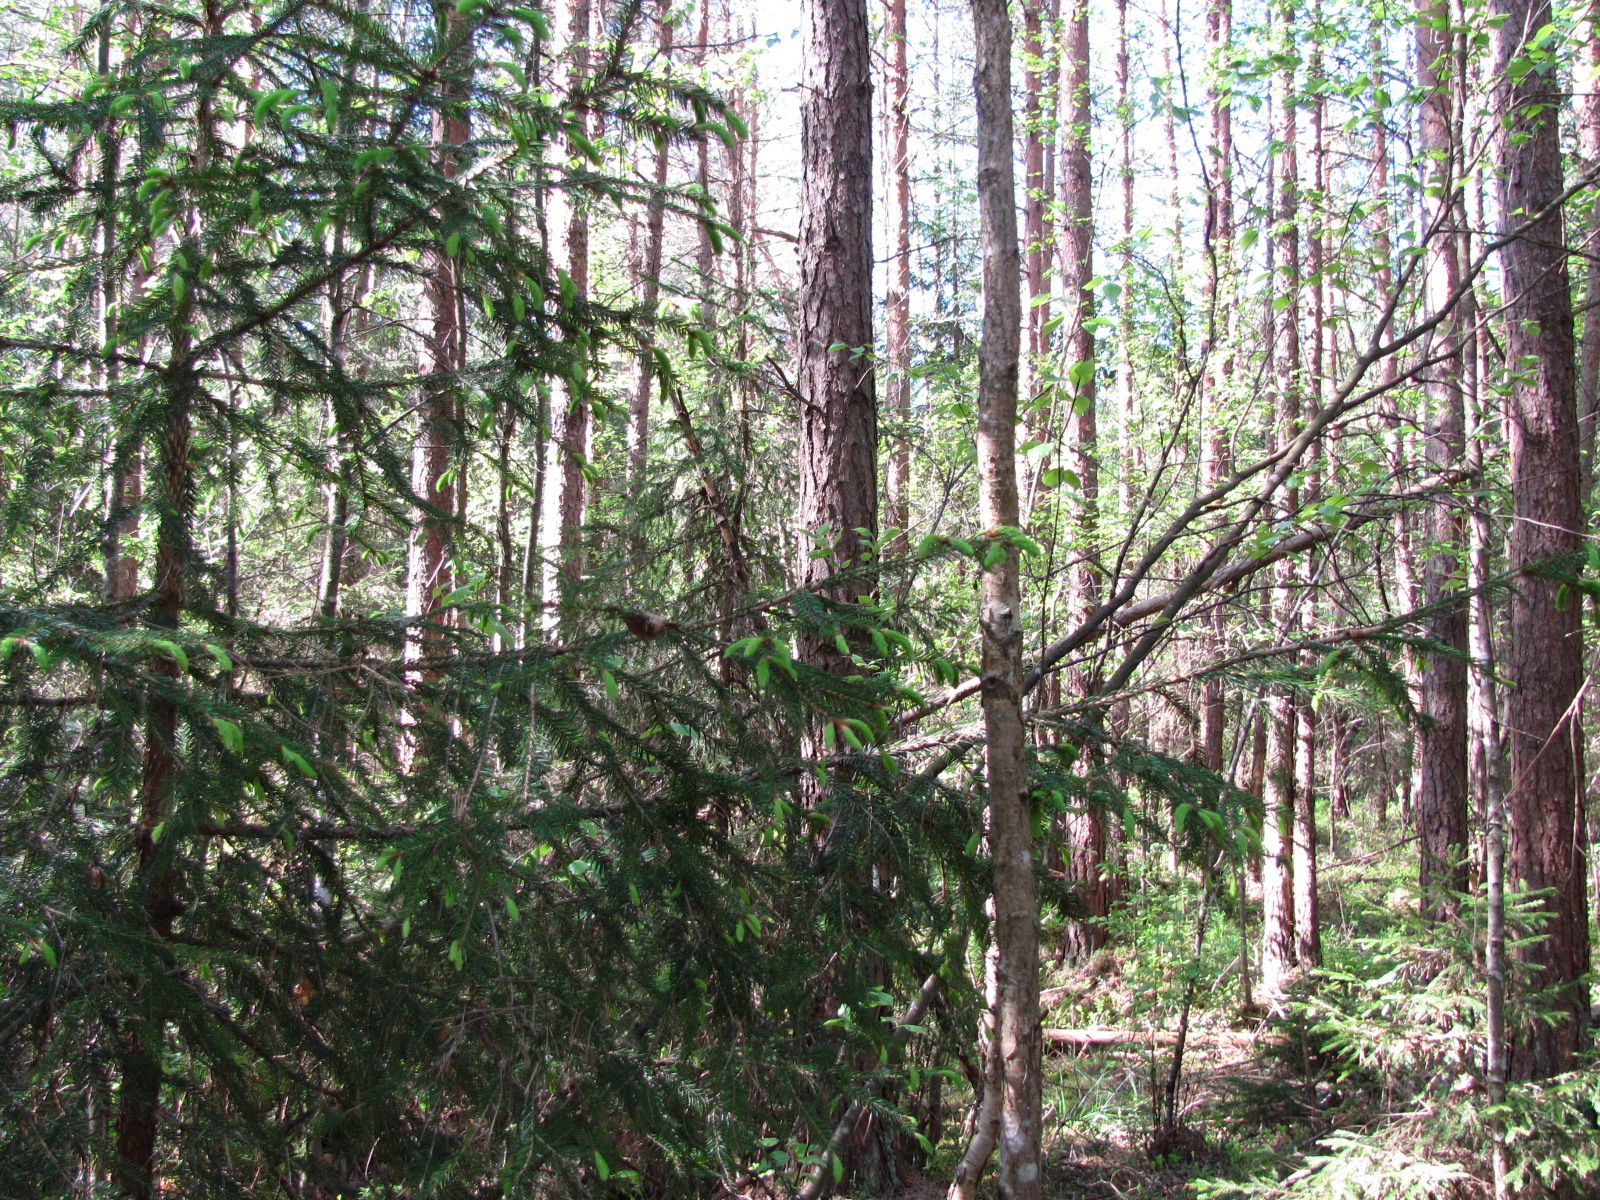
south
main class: Woodland
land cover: Other mixed woodland
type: hemiboreal forest and nemoral coniferous forest and mixed broadleaved-coniferous forest
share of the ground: > 75 %
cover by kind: coniferous forest trees 70 %, broadleaved forest trees 30 %
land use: Forestry
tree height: > 5 m
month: May
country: LV
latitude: 56.6444
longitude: 24.1278
